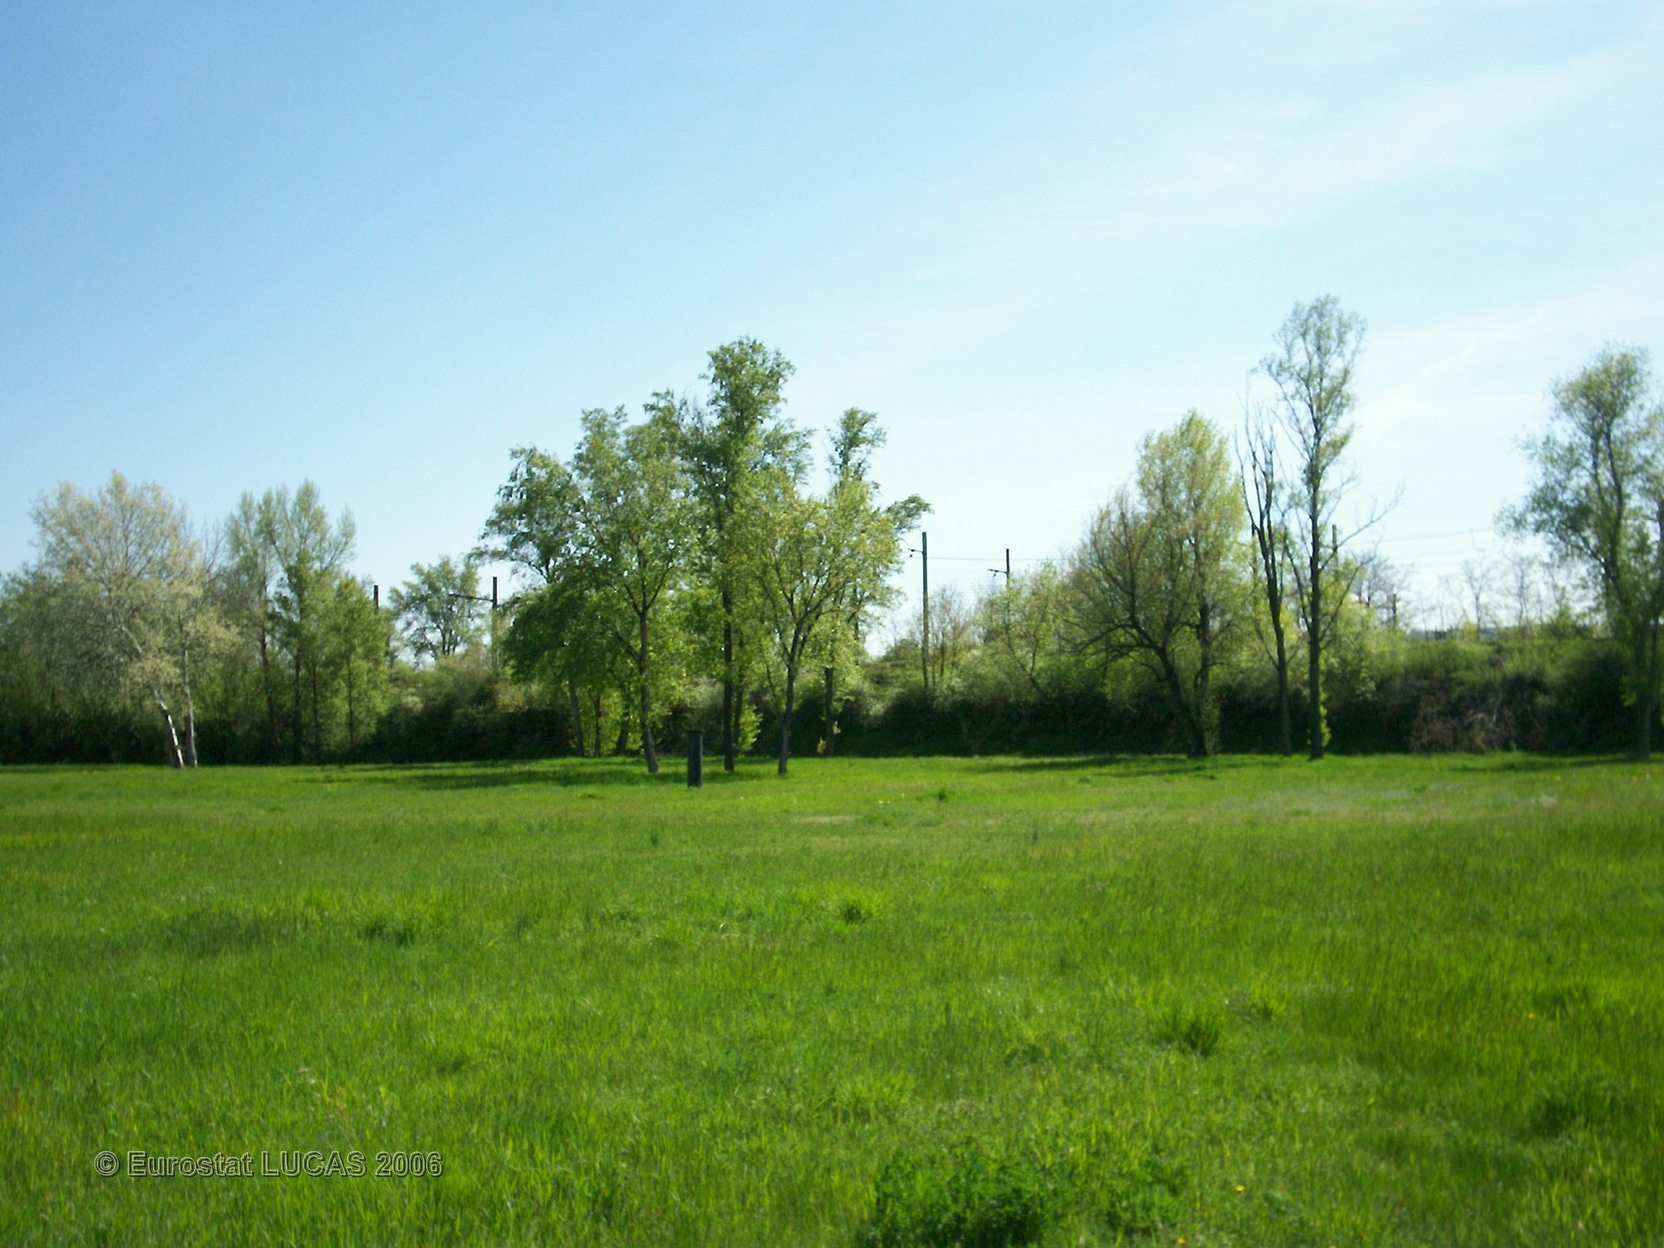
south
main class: Grassland
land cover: Grassland without tree/shrub cover
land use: Road transport
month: April
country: FR
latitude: 45.5923
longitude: 4.7867
